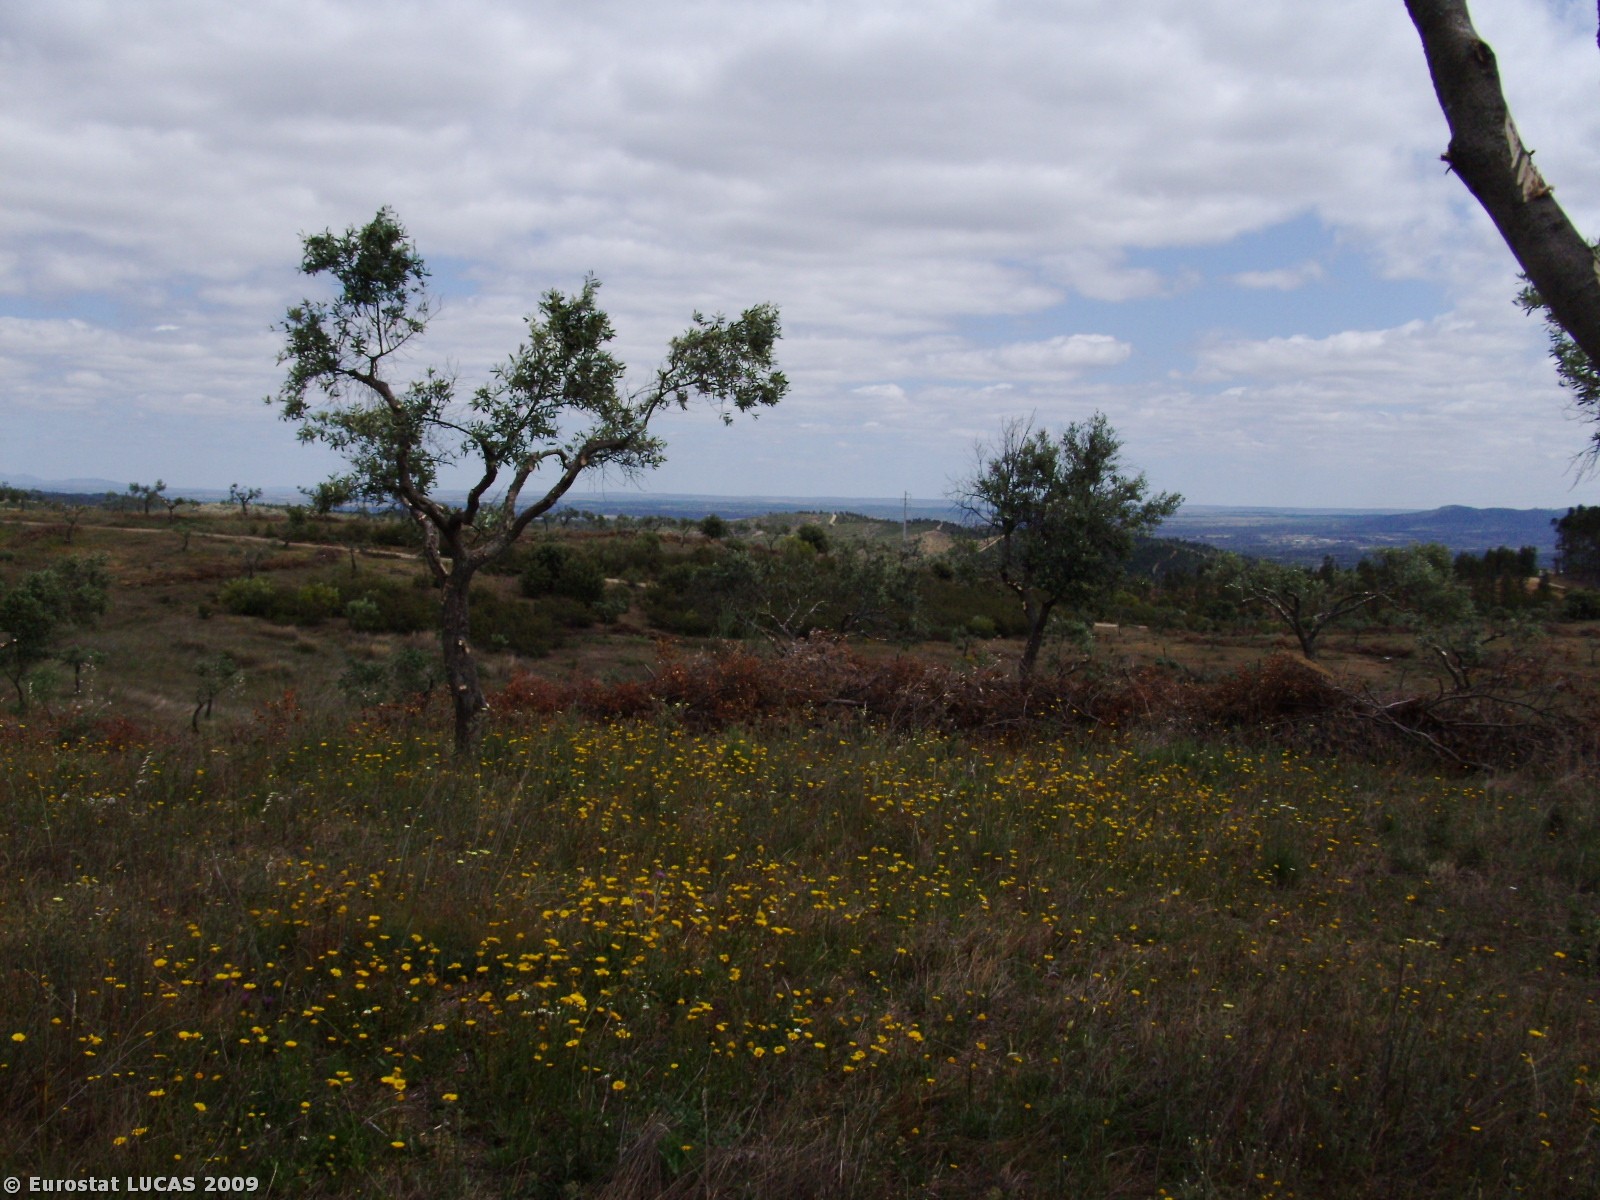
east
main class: Cropland
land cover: Olive groves
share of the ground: 25 - 50 %
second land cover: Spontaneously vegetated surfaces
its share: 50 - 75 %
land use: Agriculture (excluding fallow land and kitchen gardens)
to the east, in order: Olive groves; Spontaneously vegetated surfaces; Olive groves; Shrubland with sparse tree cover; Tracks; Shrubland with sparse tree cover; Olive groves
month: April
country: PT
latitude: 39.7948
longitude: -7.4636
